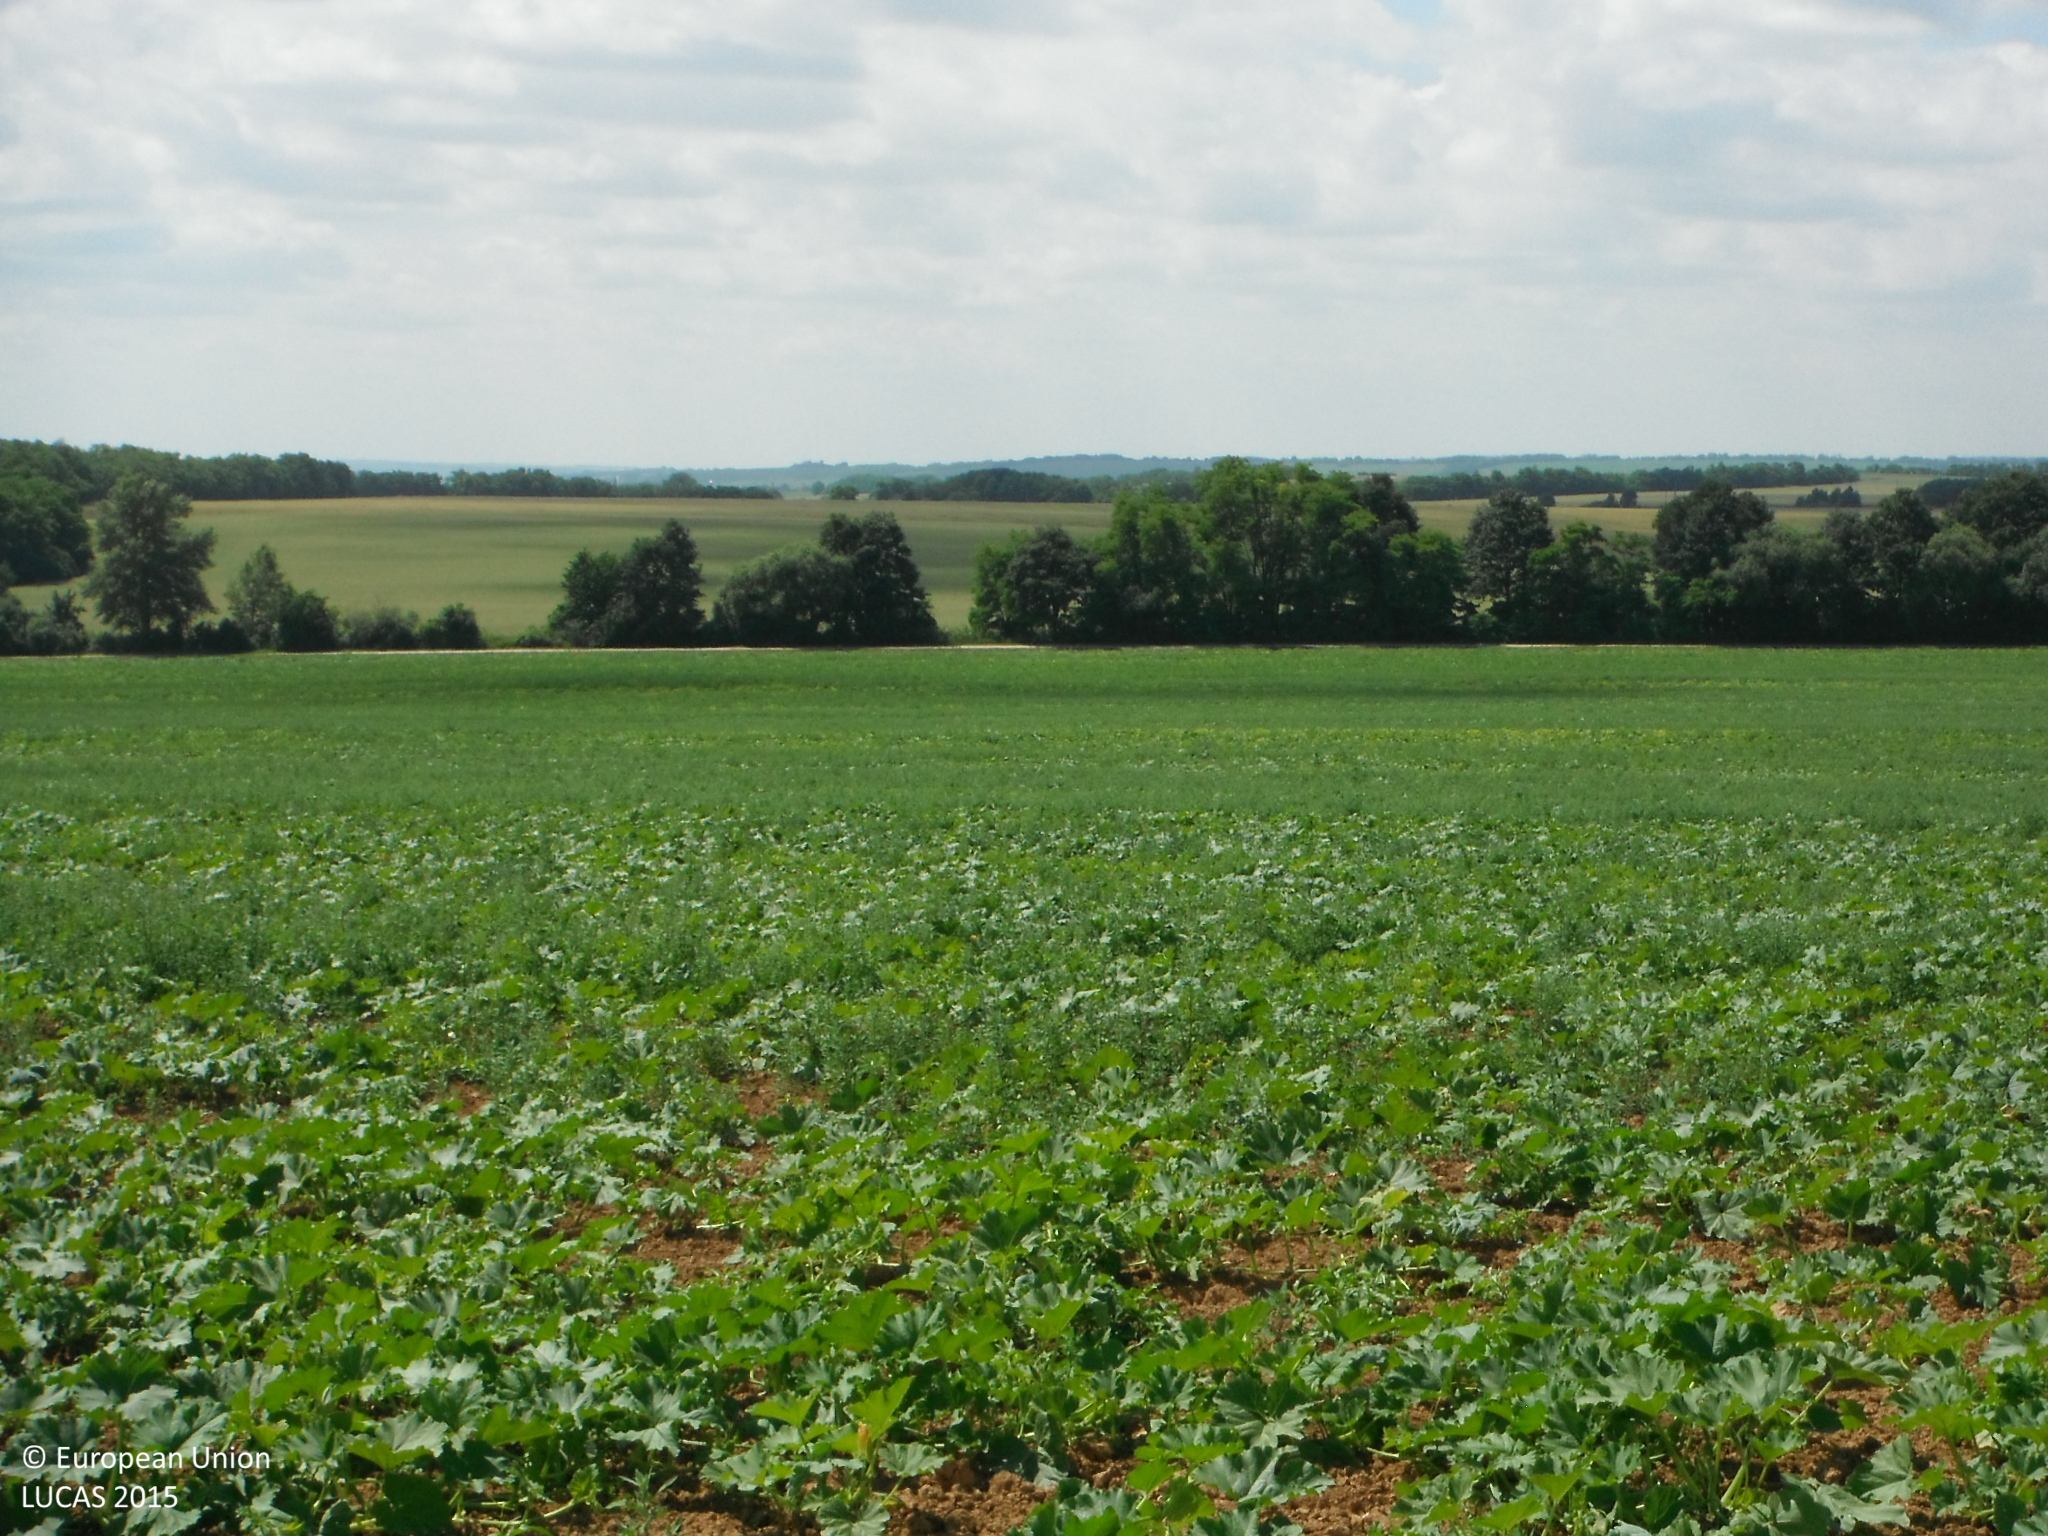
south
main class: Cropland
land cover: Other fresh vegetables
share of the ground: 25 - 50 %
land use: Agriculture (excluding fallow land and kitchen gardens)
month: June
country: SK
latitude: 48.3989
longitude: 18.2949
